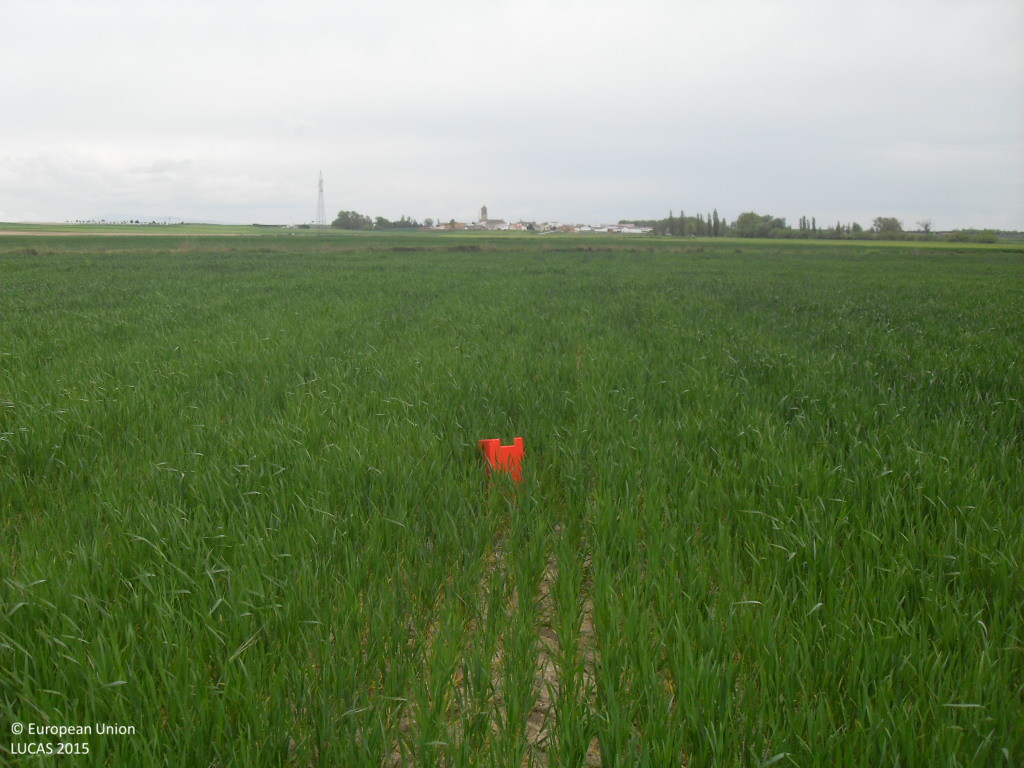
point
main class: Cropland
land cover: Common wheat
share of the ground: > 75 %
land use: Agriculture (excluding fallow land and kitchen gardens)
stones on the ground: < 10 %
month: April
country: ES
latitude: 40.9183
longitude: -5.1587
